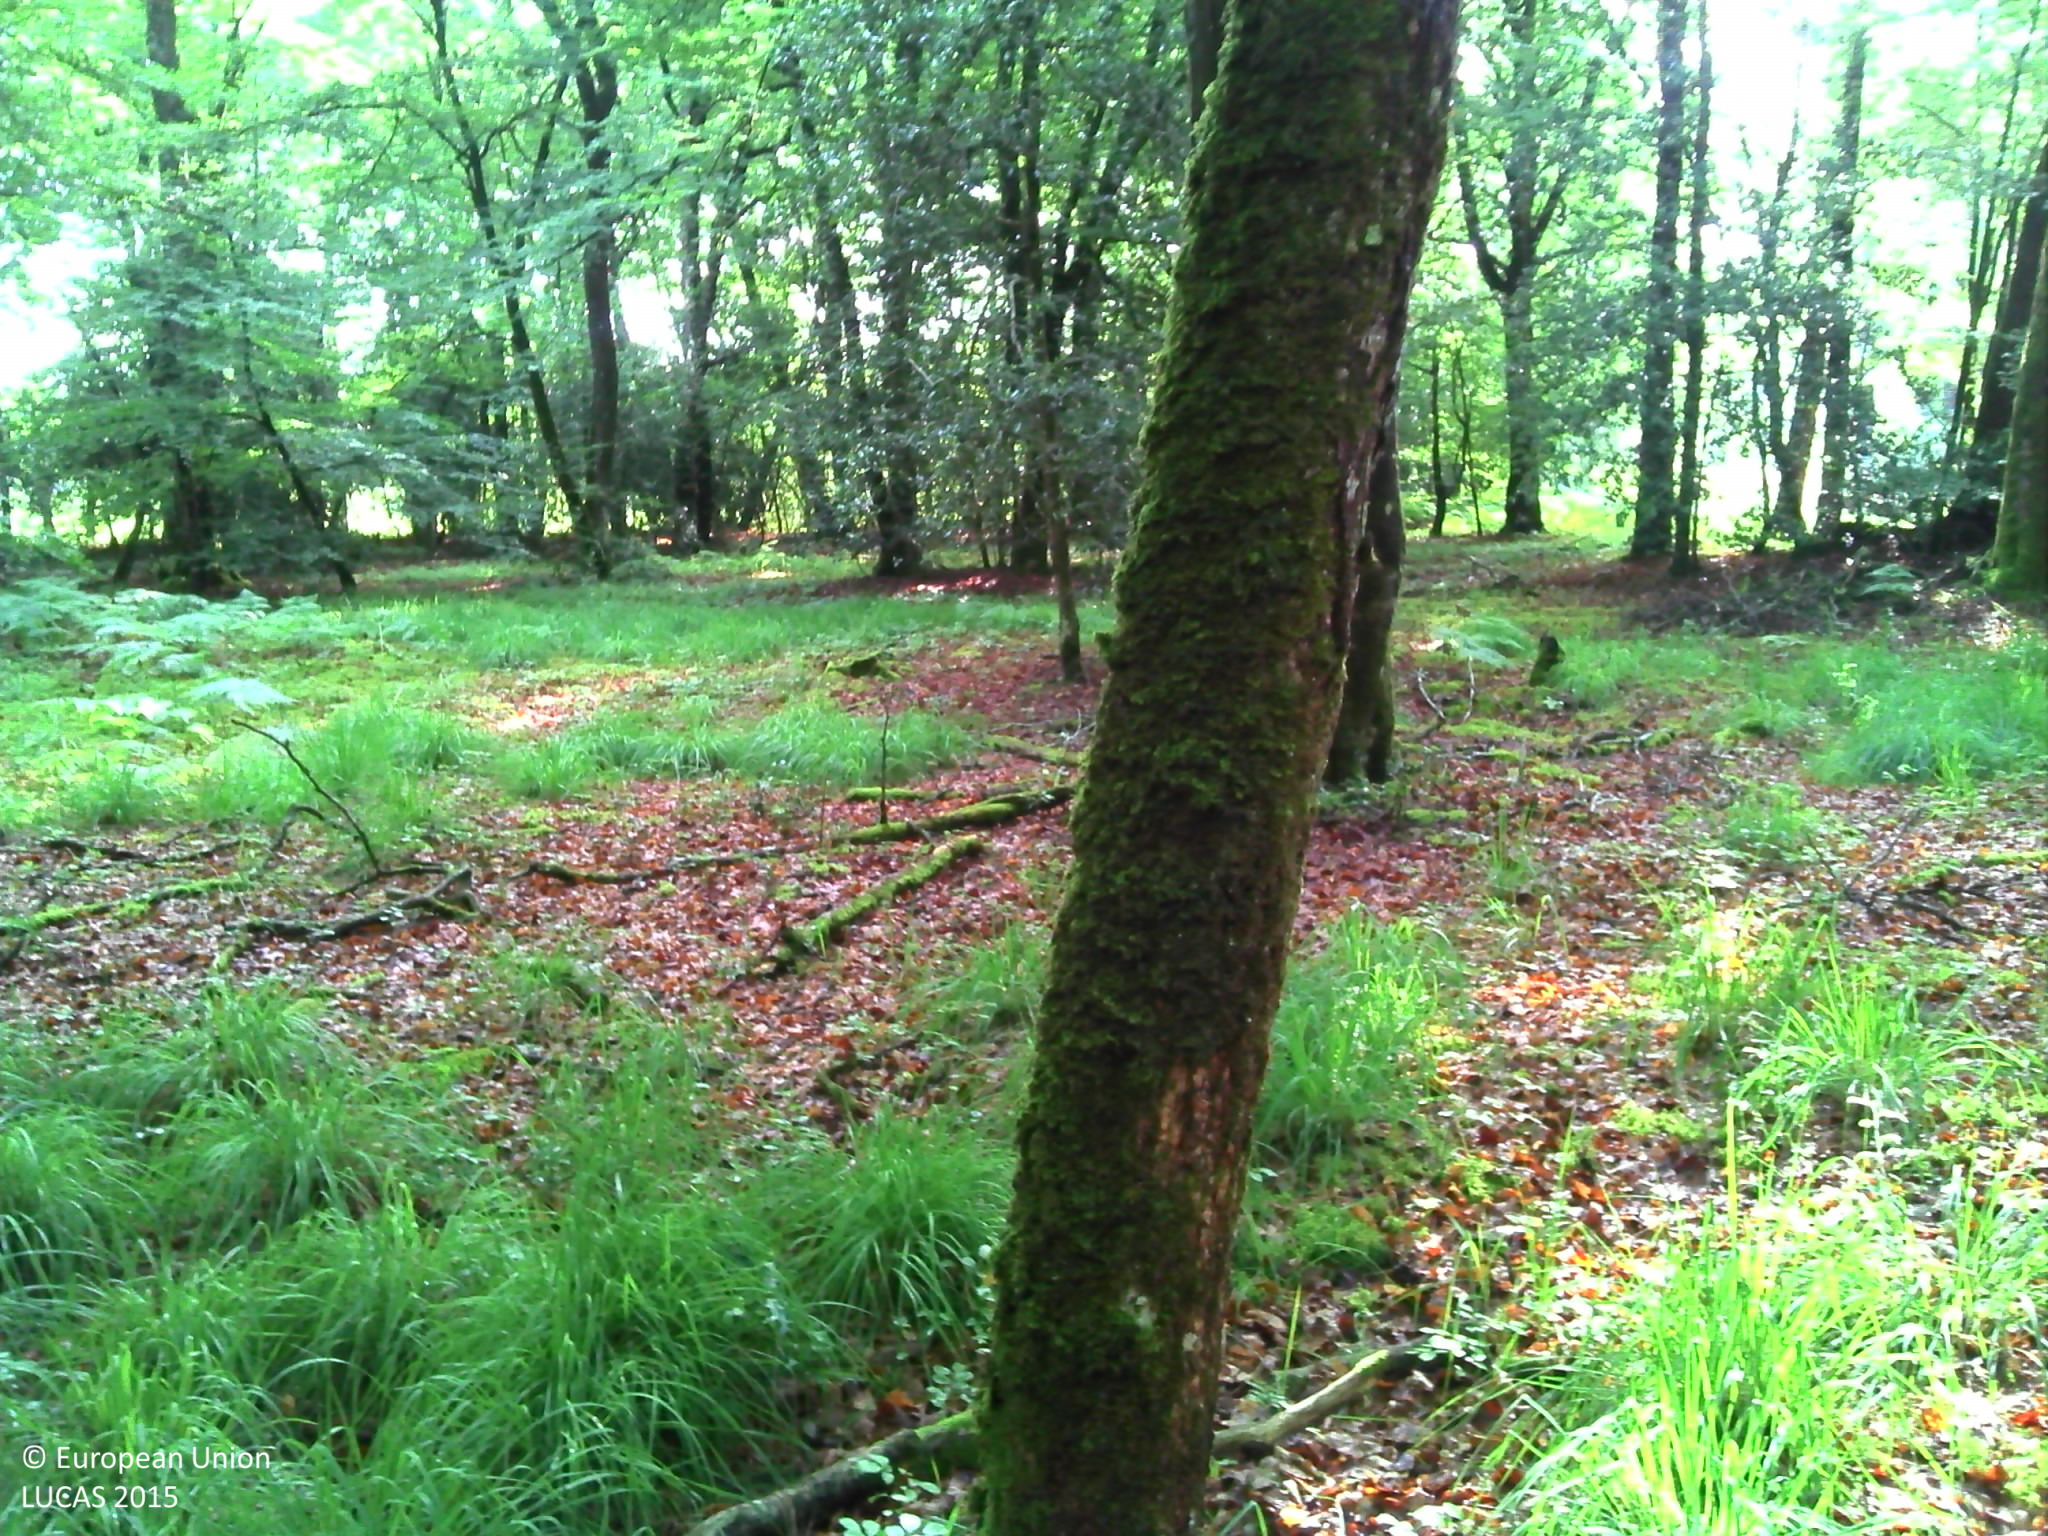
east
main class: Woodland
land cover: Broadleaved woodland
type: acidophilous oak and oak-birch forest
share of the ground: > 75 %
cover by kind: broadleaved forest trees 90 %, herbaceous plants 5 %, lichens and mosses 5 %
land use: Forestry
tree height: > 5 m
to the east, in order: Broadleaved woodland; Shrubland without tree cover; Broadleaved woodland; Ditches and canals; Shrubland without tree cover; Broadleaved woodland
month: June
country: FR
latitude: 48.2752
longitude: -1.4857
